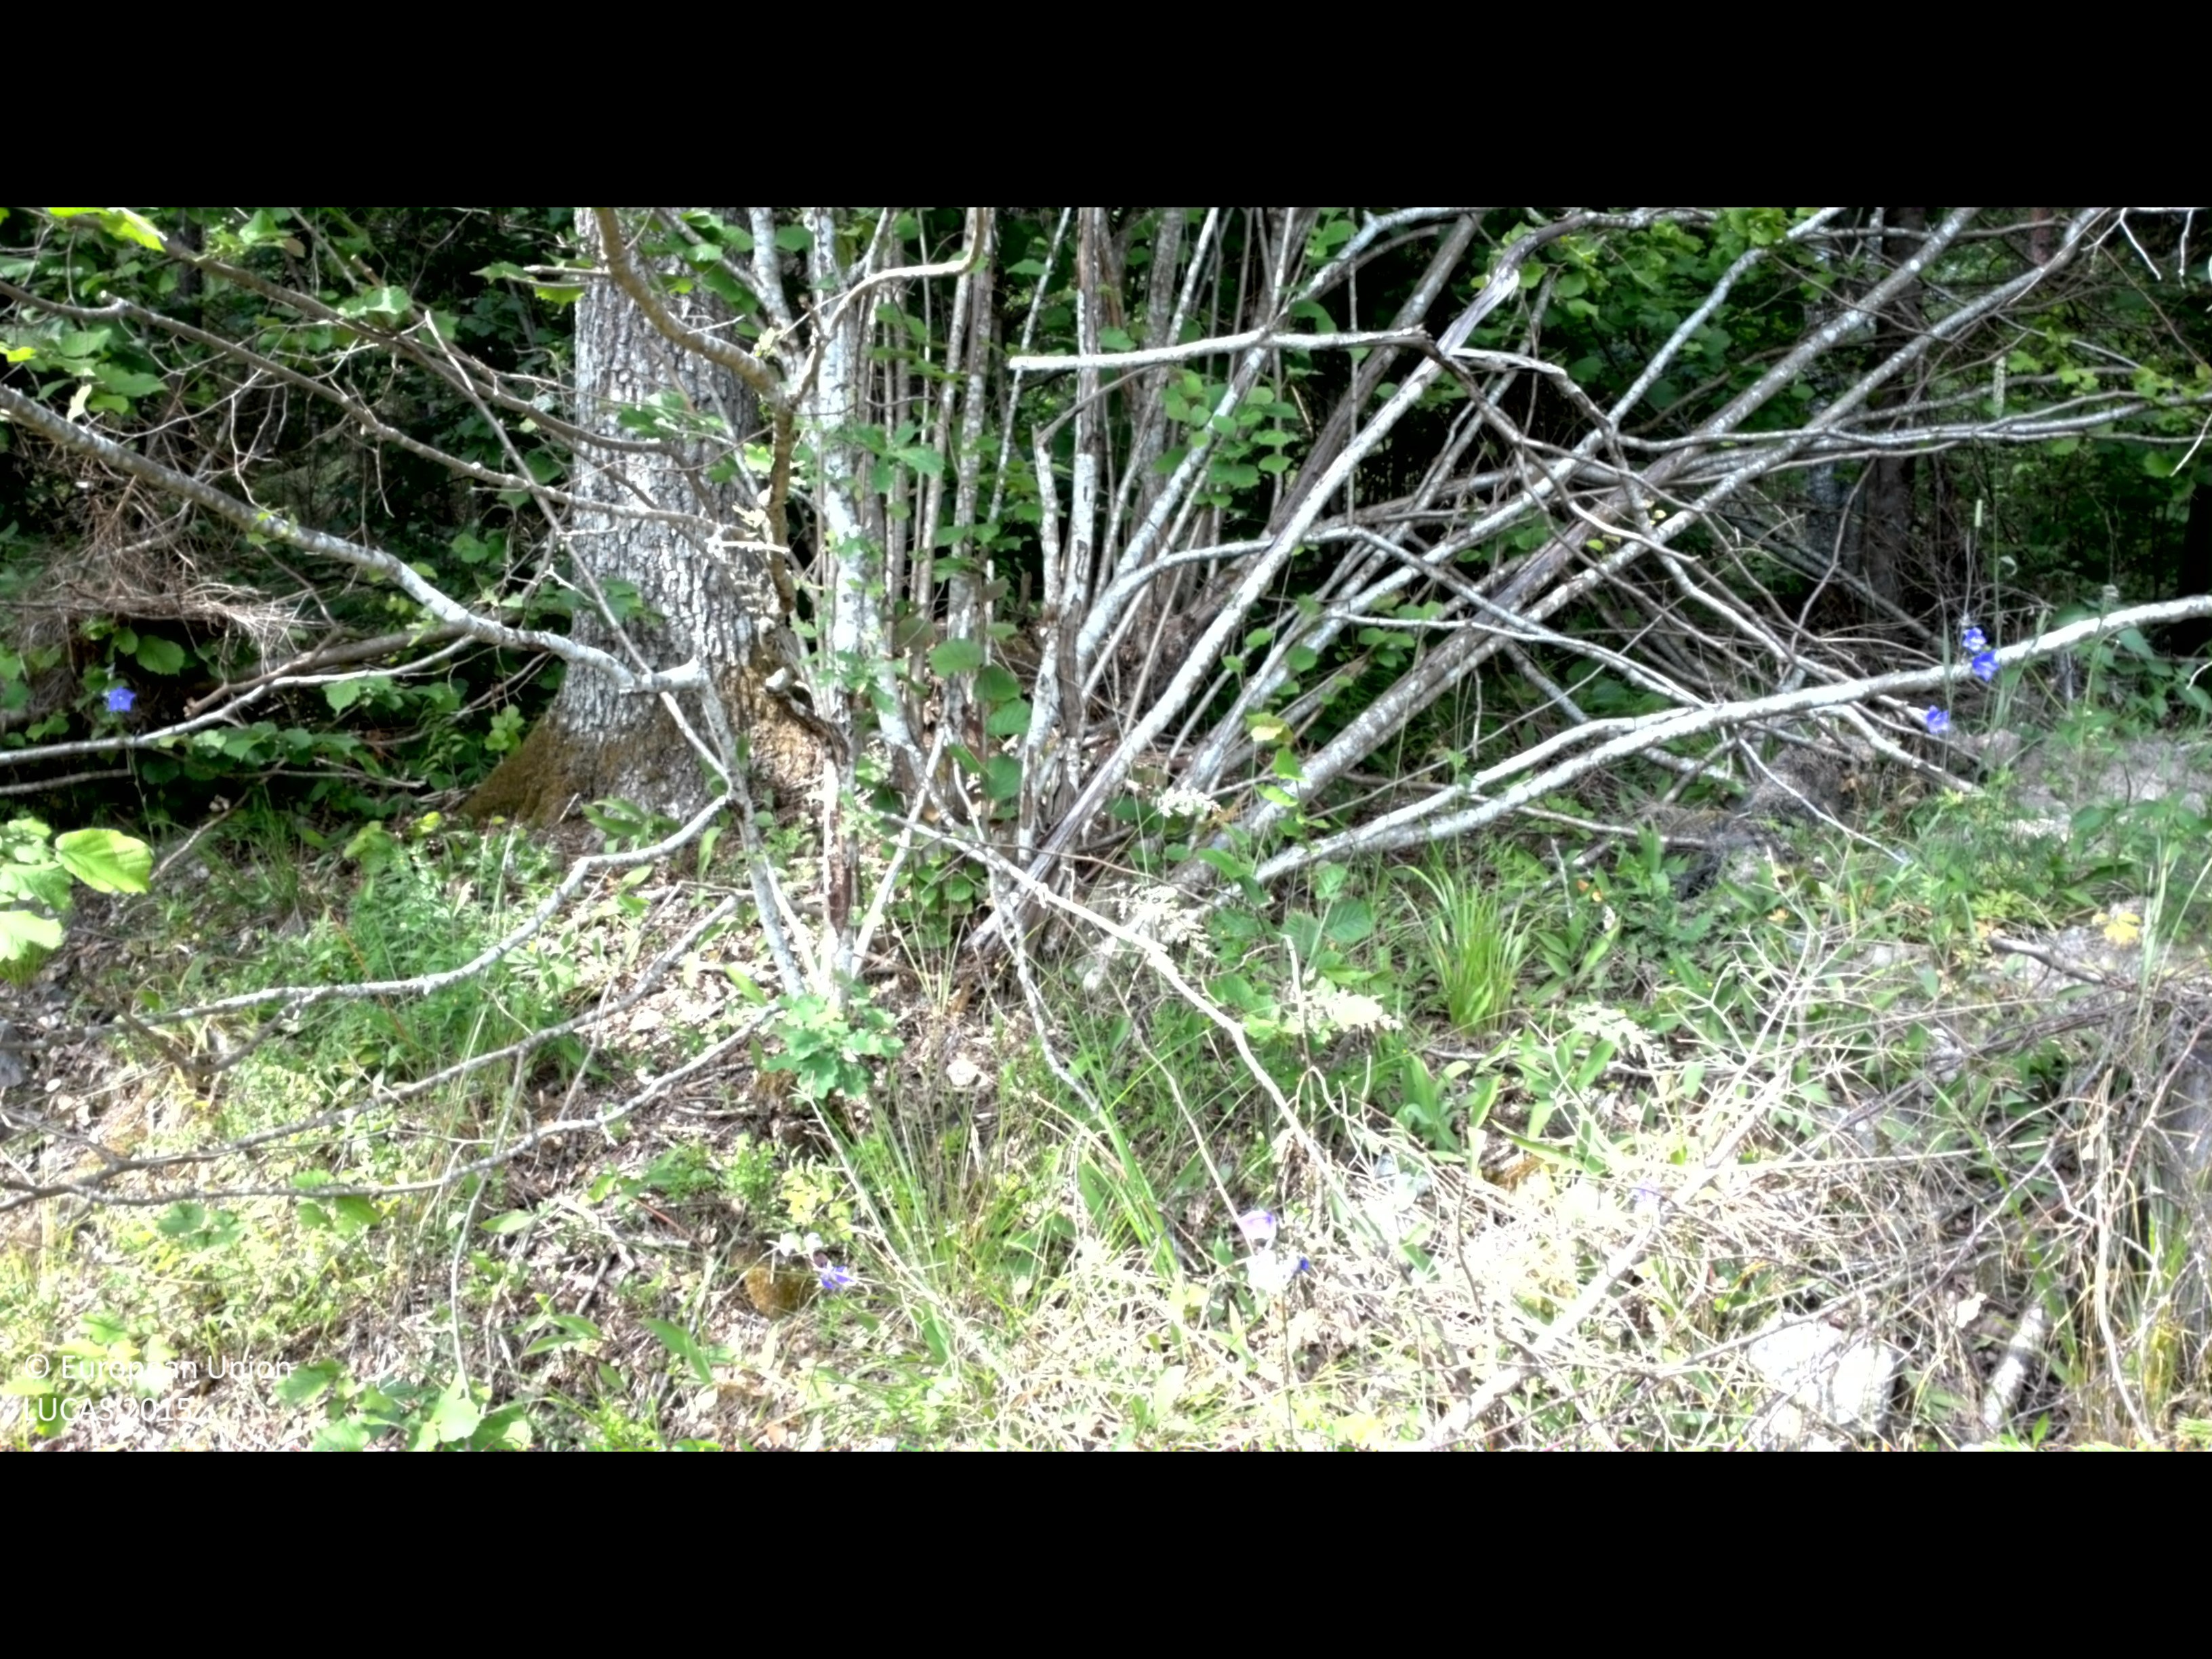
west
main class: Woodland
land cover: Other mixed woodland
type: boreal forest
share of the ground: > 75 %
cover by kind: coniferous forest trees 50 %, broadleaved forest trees 30 %, shrubs 15 %, herbaceous plants 5 %
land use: Forestry
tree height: > 5 m
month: July
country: SE
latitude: 58.2905
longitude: 16.6326
